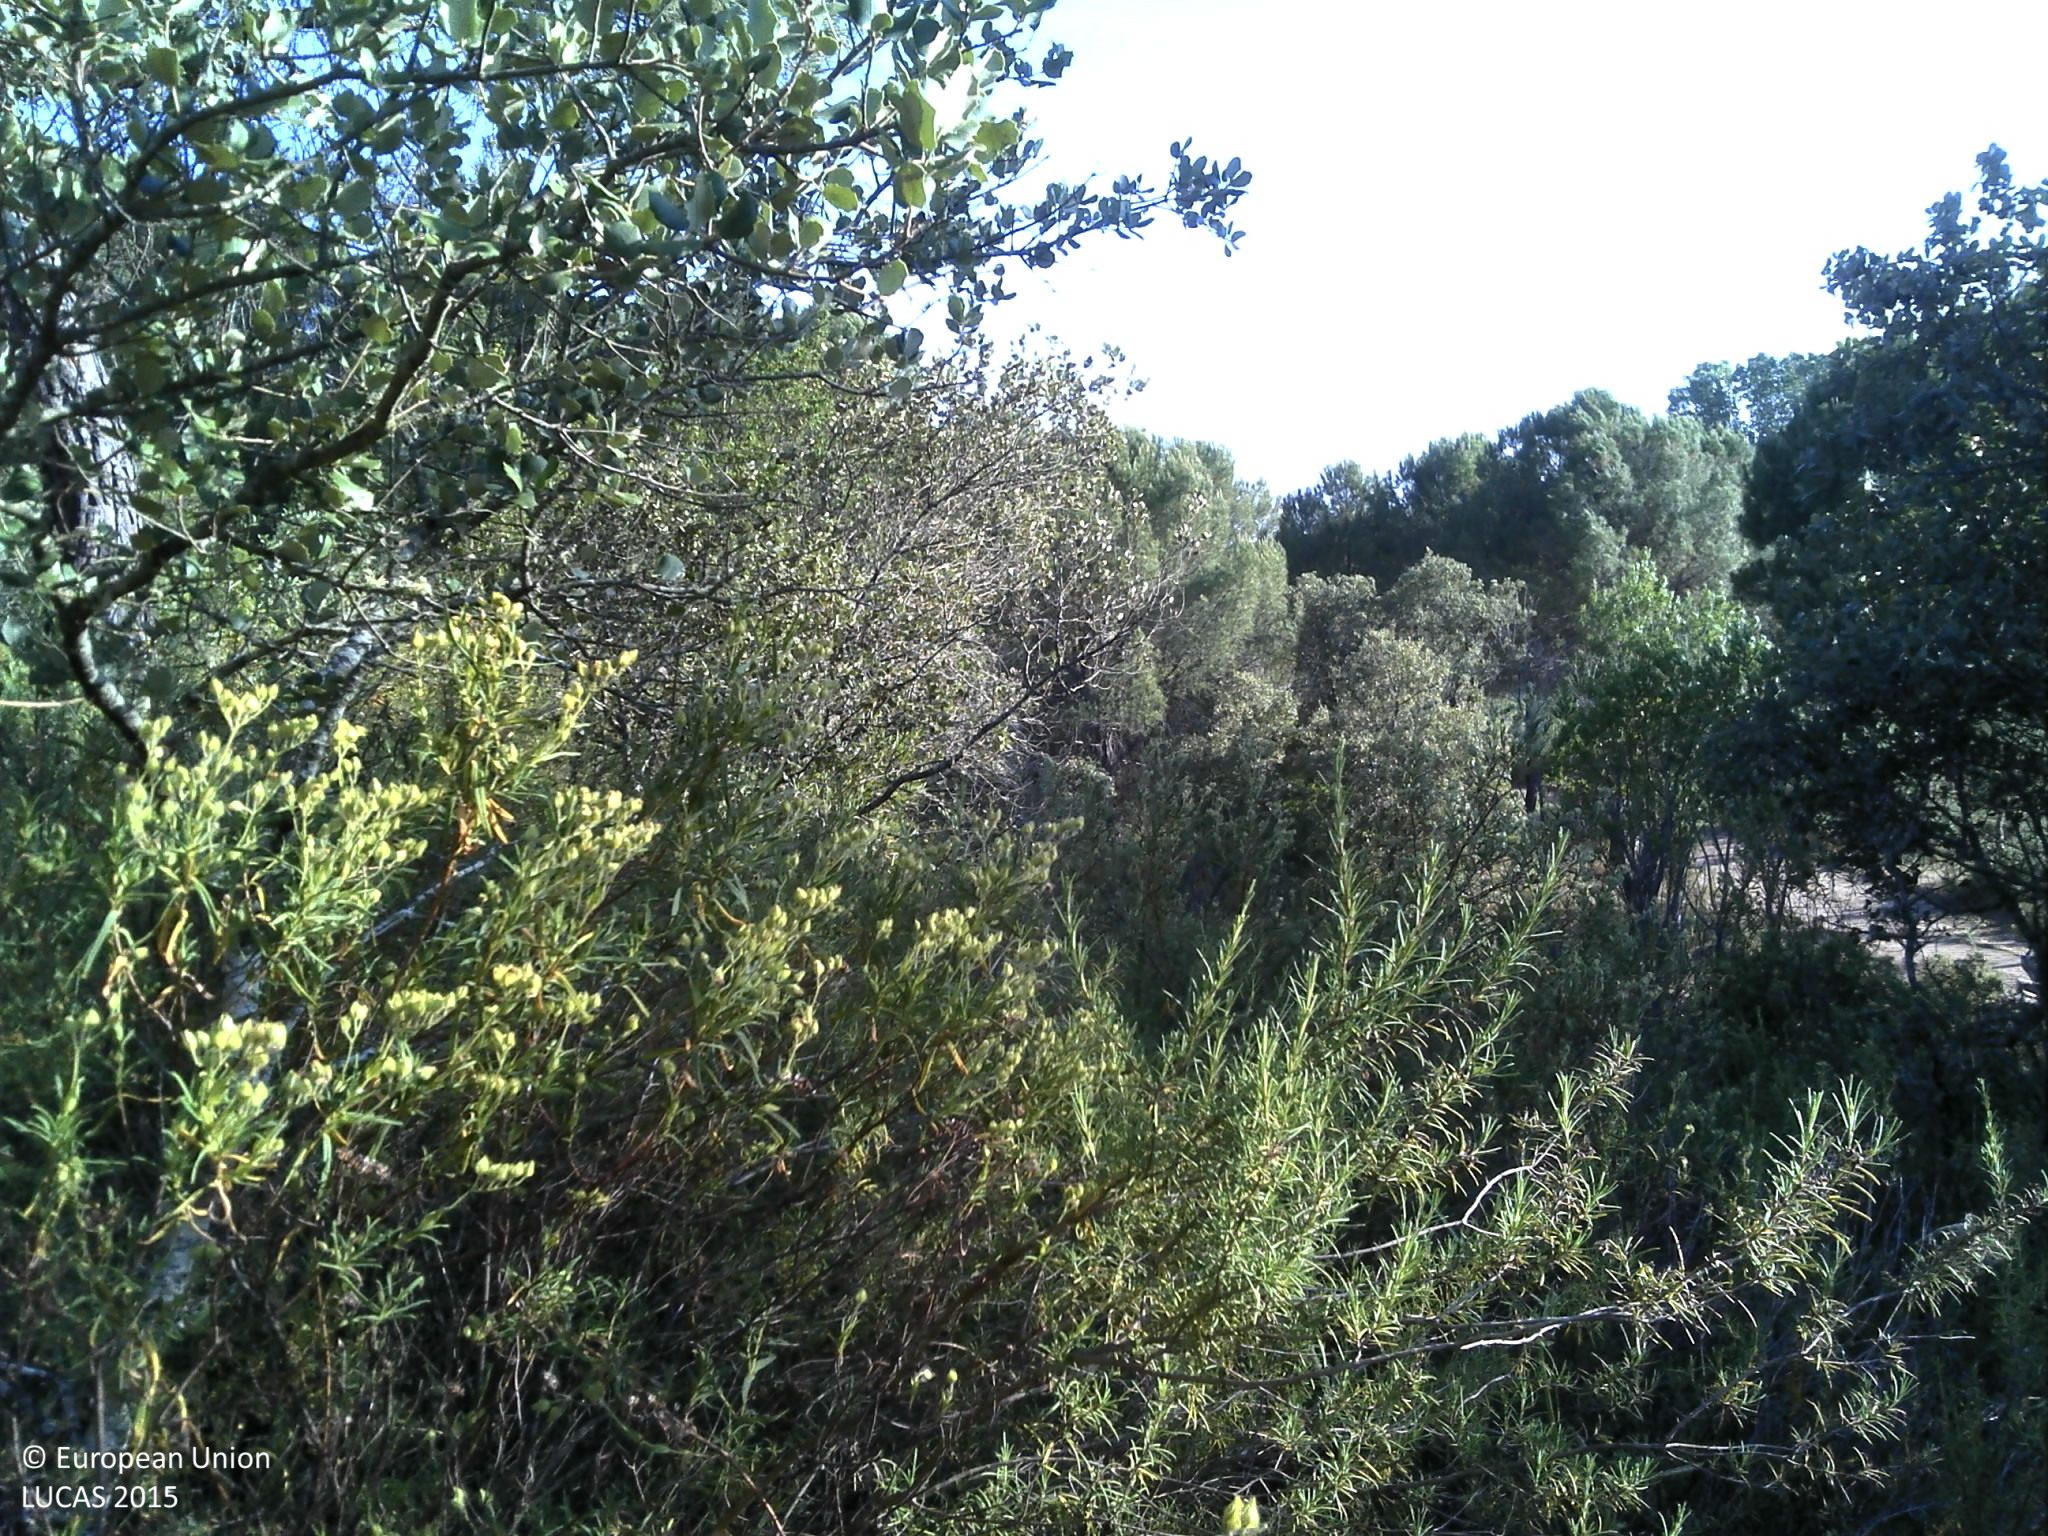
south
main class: Woodland
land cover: Broadleaved woodland
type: broadleaved evergreen forest
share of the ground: 25 - 50 %
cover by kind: shrubs 50 %, broadleaved forest trees 30 %, unconsolidated bare surface 15 %, coniferous forest trees 5 %
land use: Forestry
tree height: > 5 m
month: May
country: PT
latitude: 38.1045
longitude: -8.3917
